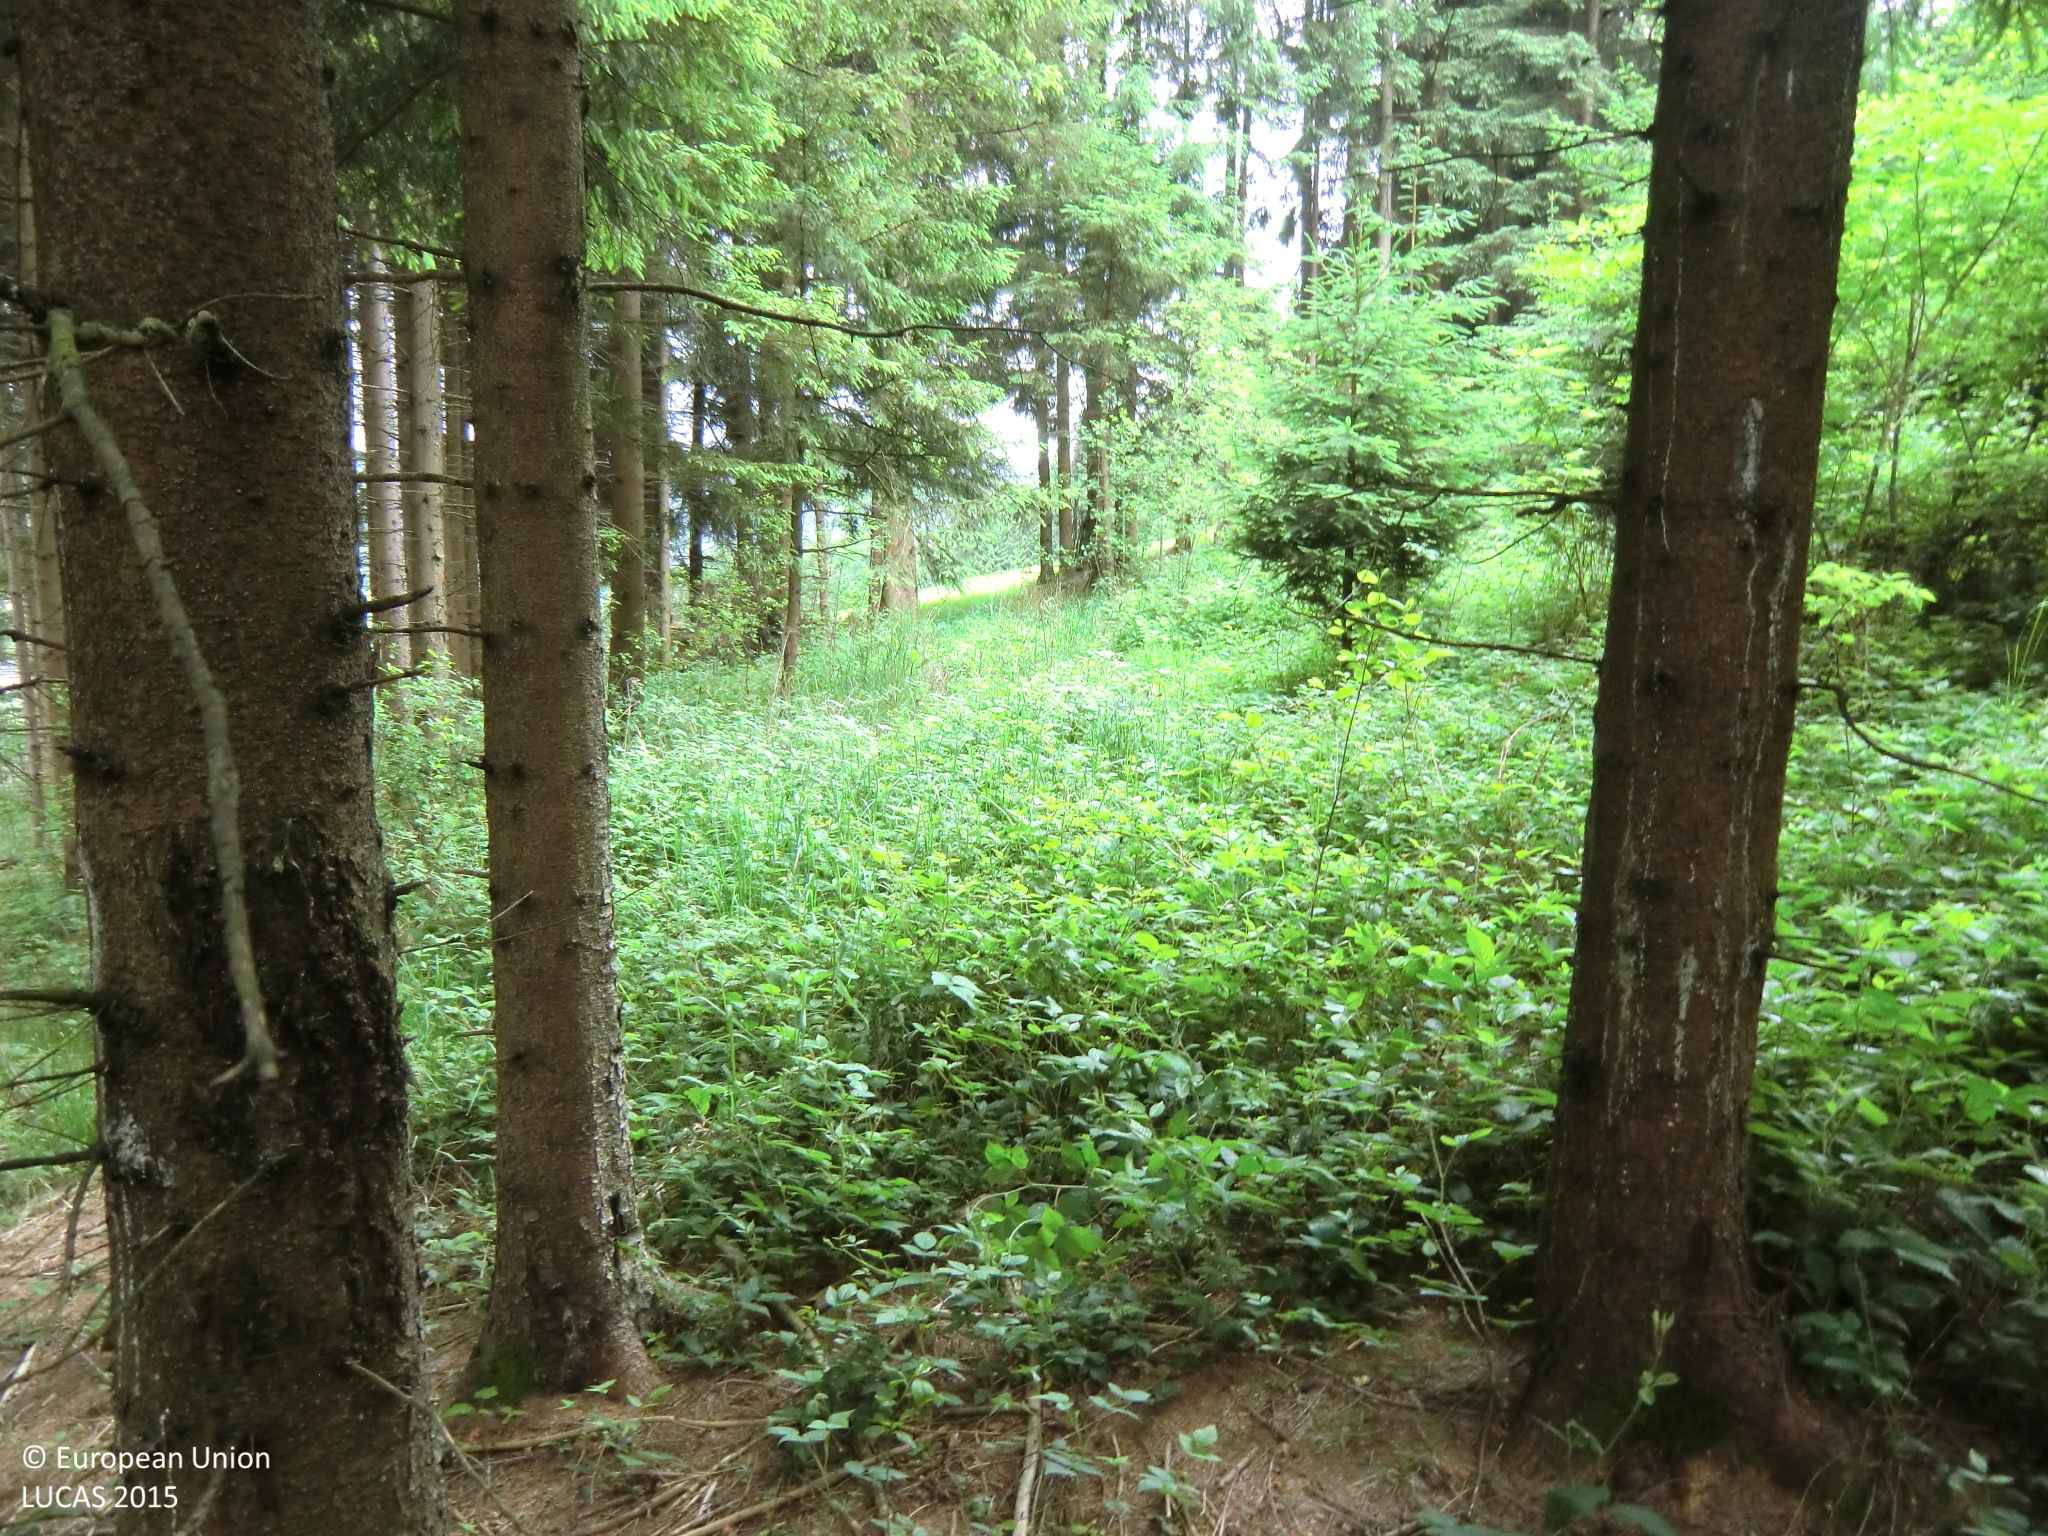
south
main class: Woodland
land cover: Spruce dominated coniferous woodland
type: hemiboreal forest and nemoral coniferous forest and mixed broadleaved-coniferous forest
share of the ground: > 75 %
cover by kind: coniferous forest trees 90 %, unconsolidated bare surface 10 %
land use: Forestry
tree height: > 5 m
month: June
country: AT
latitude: 48.2700
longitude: 15.0537
